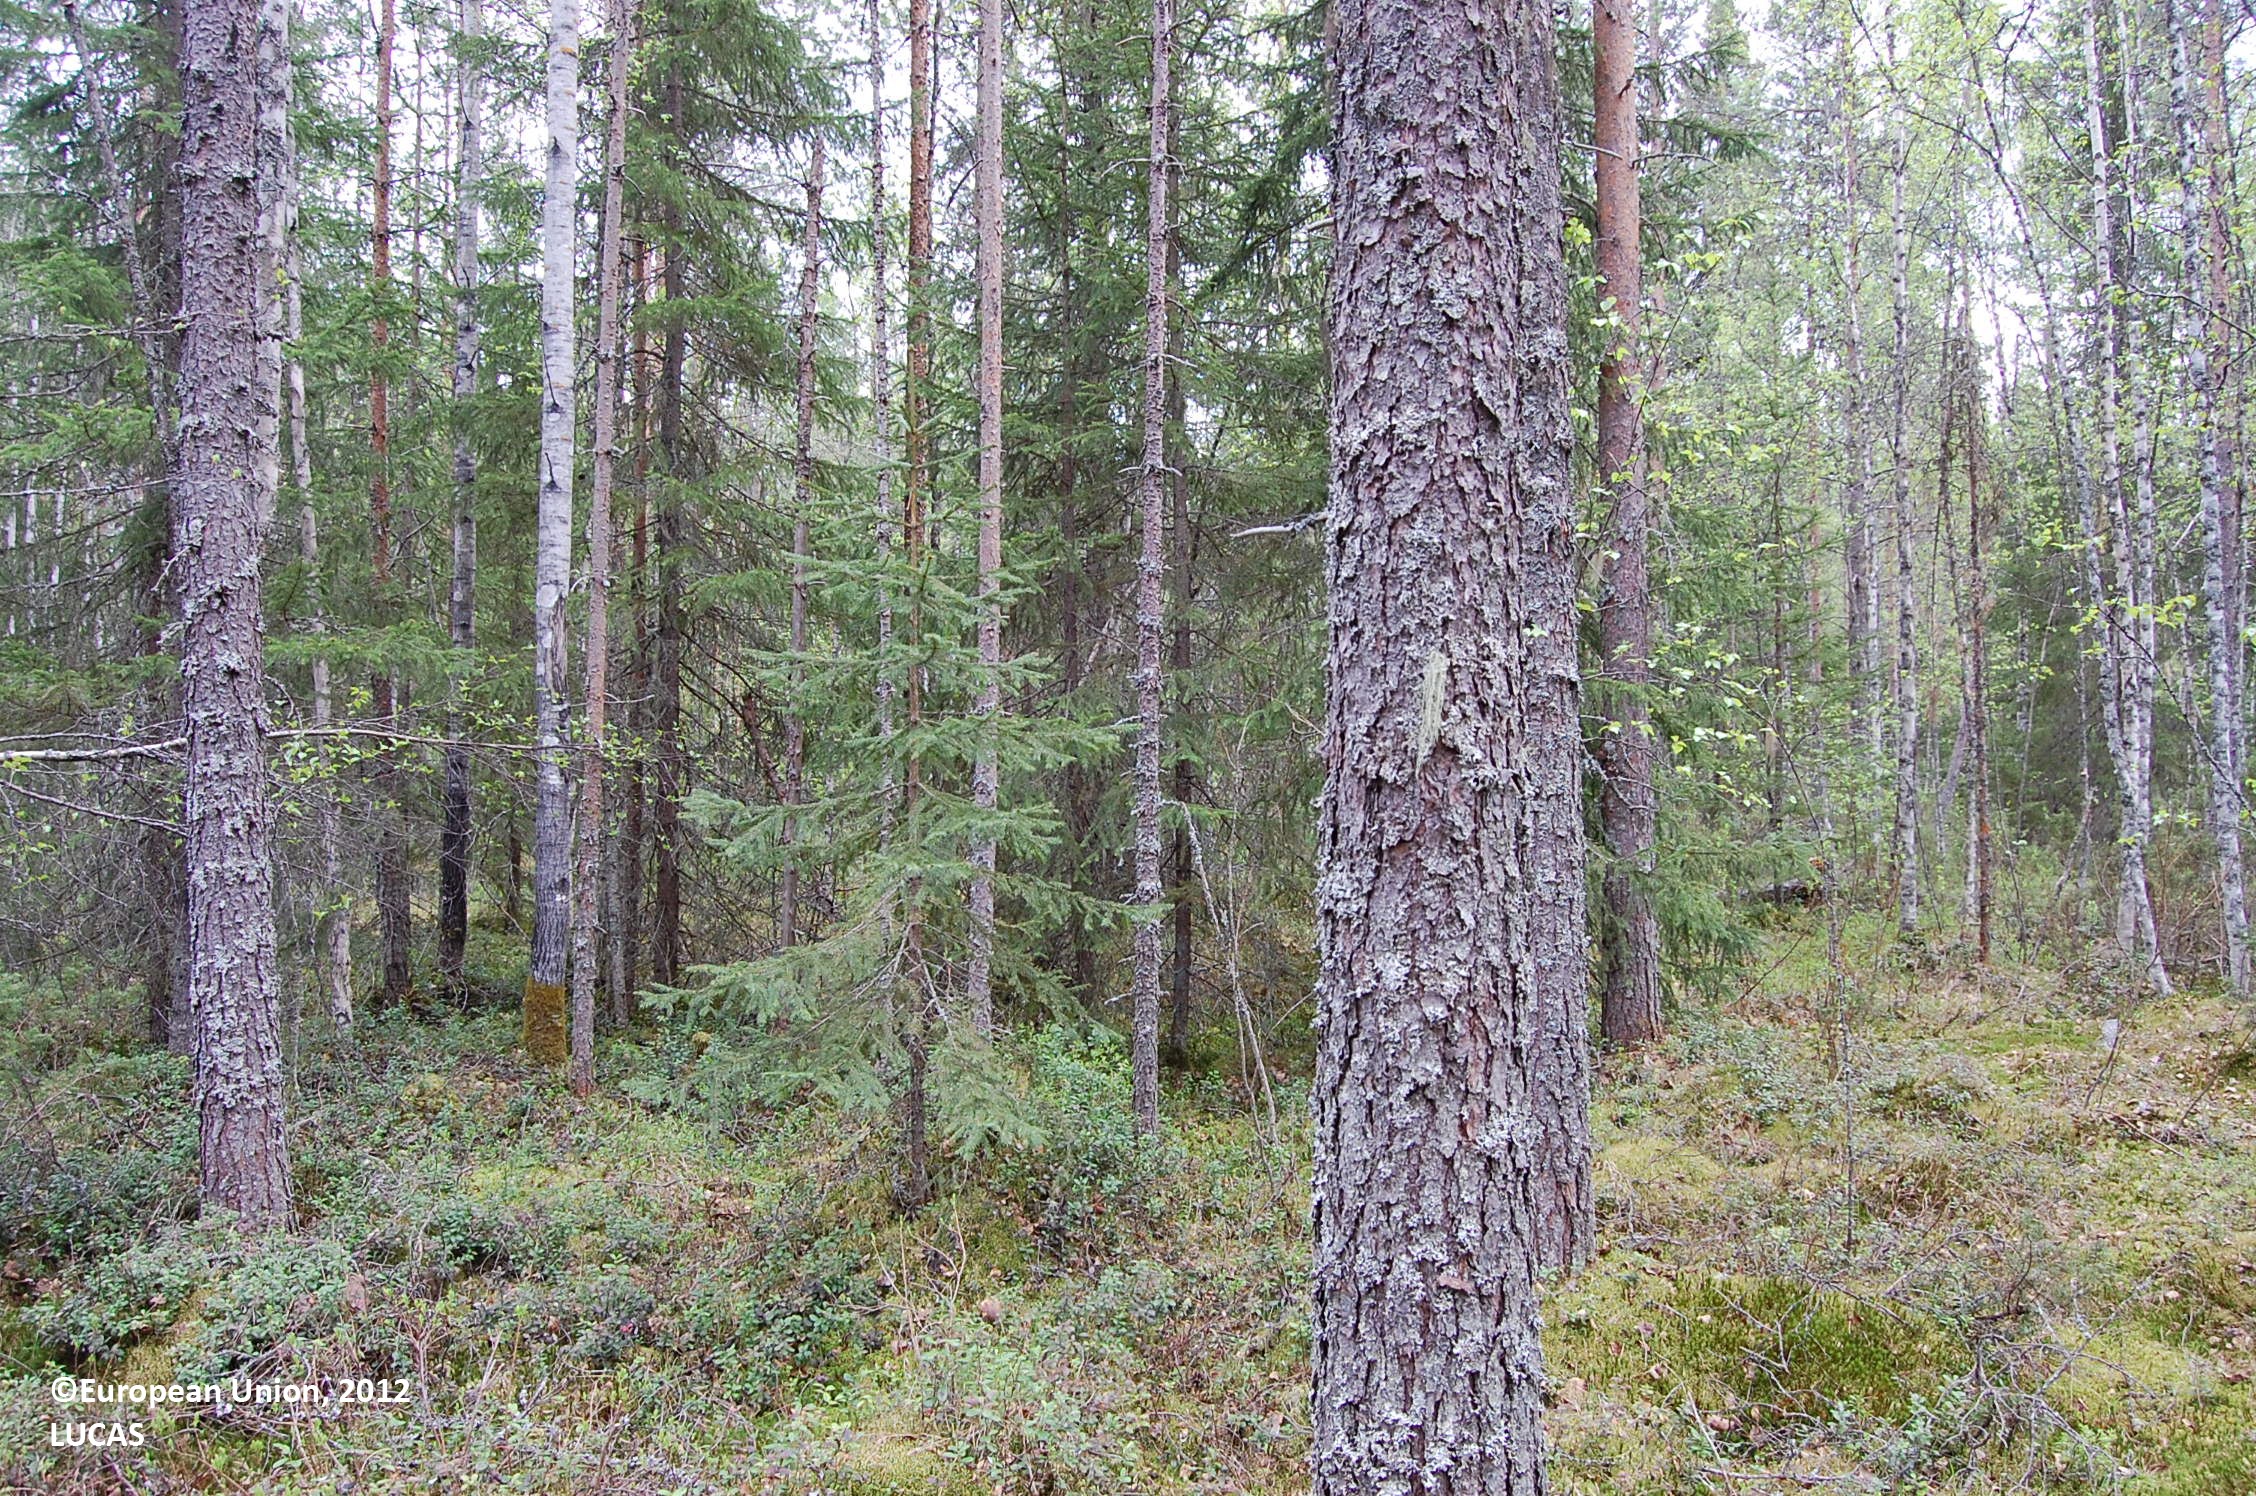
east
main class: Woodland
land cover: Other mixed woodland
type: boreal forest
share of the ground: > 75 %
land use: Forestry
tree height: > 5 m
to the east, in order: Other mixed woodland; Pine dominated mixed woodland; Ditches and canals; Pine dominated mixed woodland; Ditches and canals; Pine dominated mixed woodland; Ditches and canals; Pine dominated mixed woodland; Ditches and canals; Pine dominated mixed woodland
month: May
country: FI
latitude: 64.3632
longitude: 26.2892
